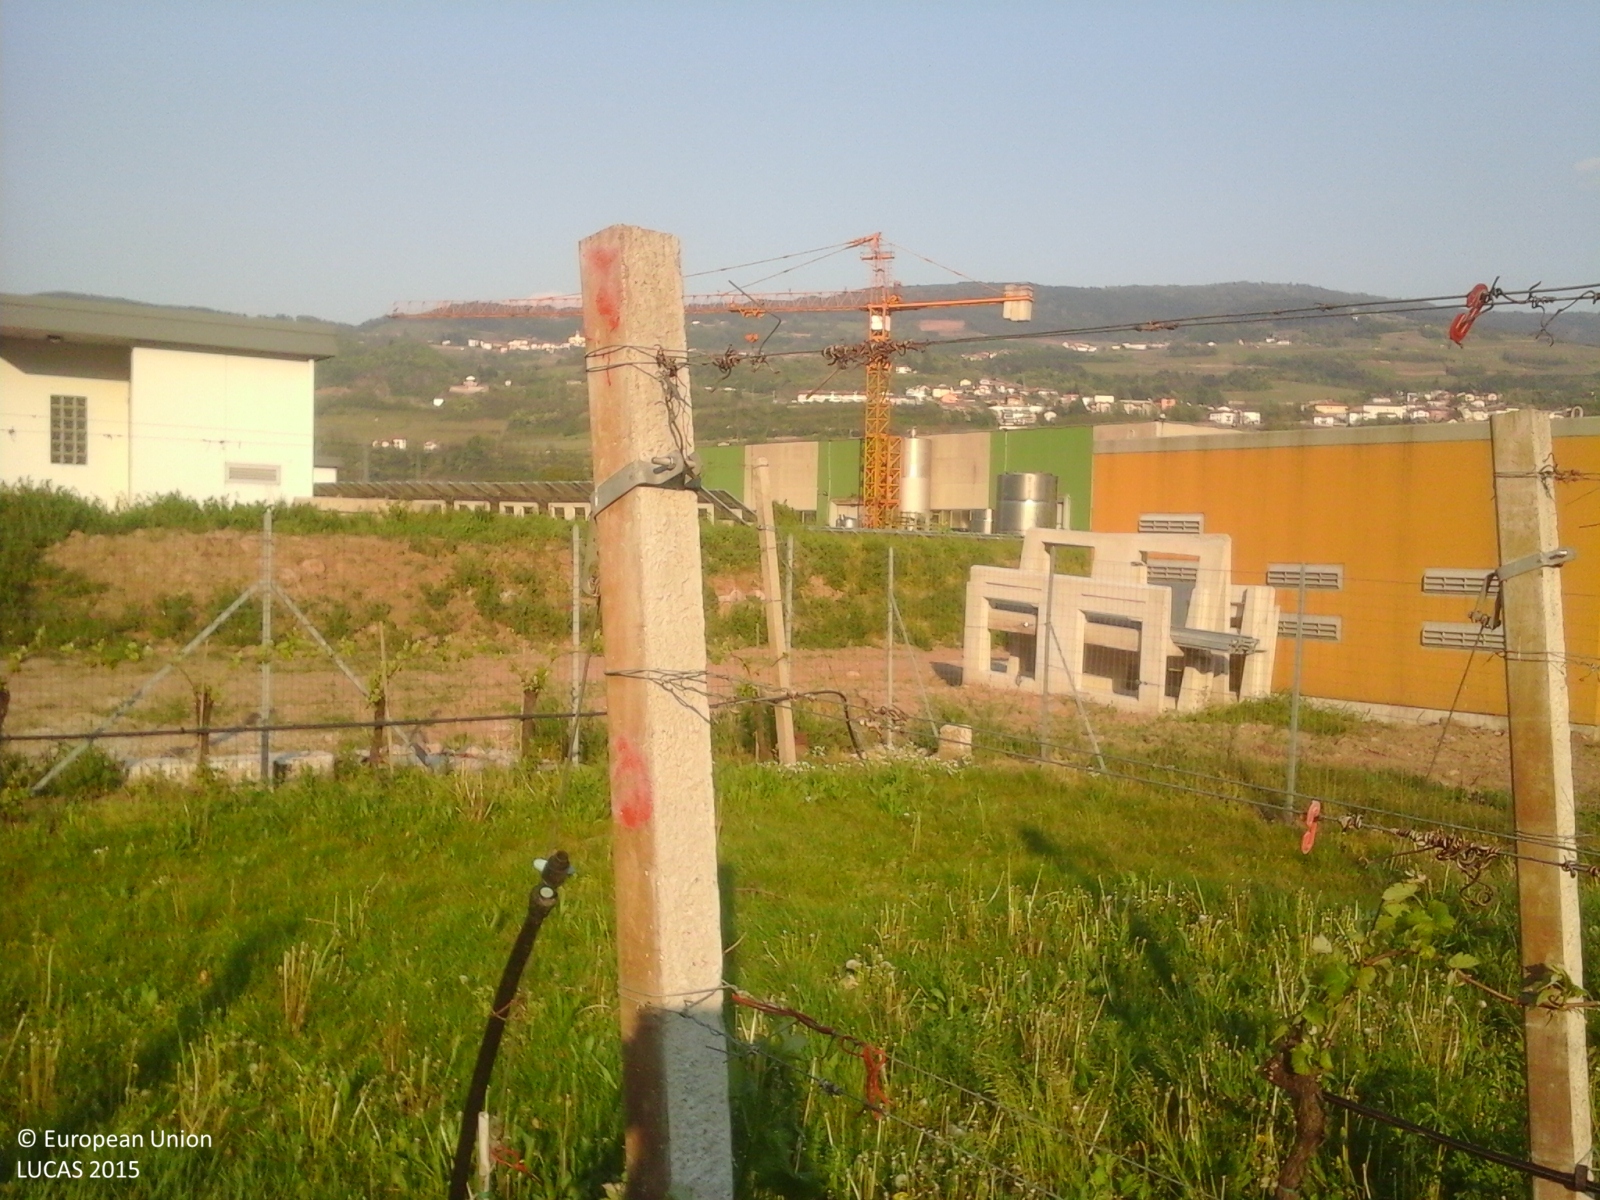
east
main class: Cropland
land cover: Vineyards
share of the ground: < 10 %
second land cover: Grassland without tree/shrub cover
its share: > 75 %
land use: Agriculture (excluding fallow land and kitchen gardens)
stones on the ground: < 10 %
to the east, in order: Vineyards; Grassland without tree/shrub cover; Grass margins; Vineyards; Artificial constructions in urban areas; Managed hedges; Vineyards; Single bushes/trees; Paved roads, cycling and walking lanes; Grass margins; Fences; Grass margins; Broadleaved woodland
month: April
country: IT
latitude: 46.1294
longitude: 11.0986
